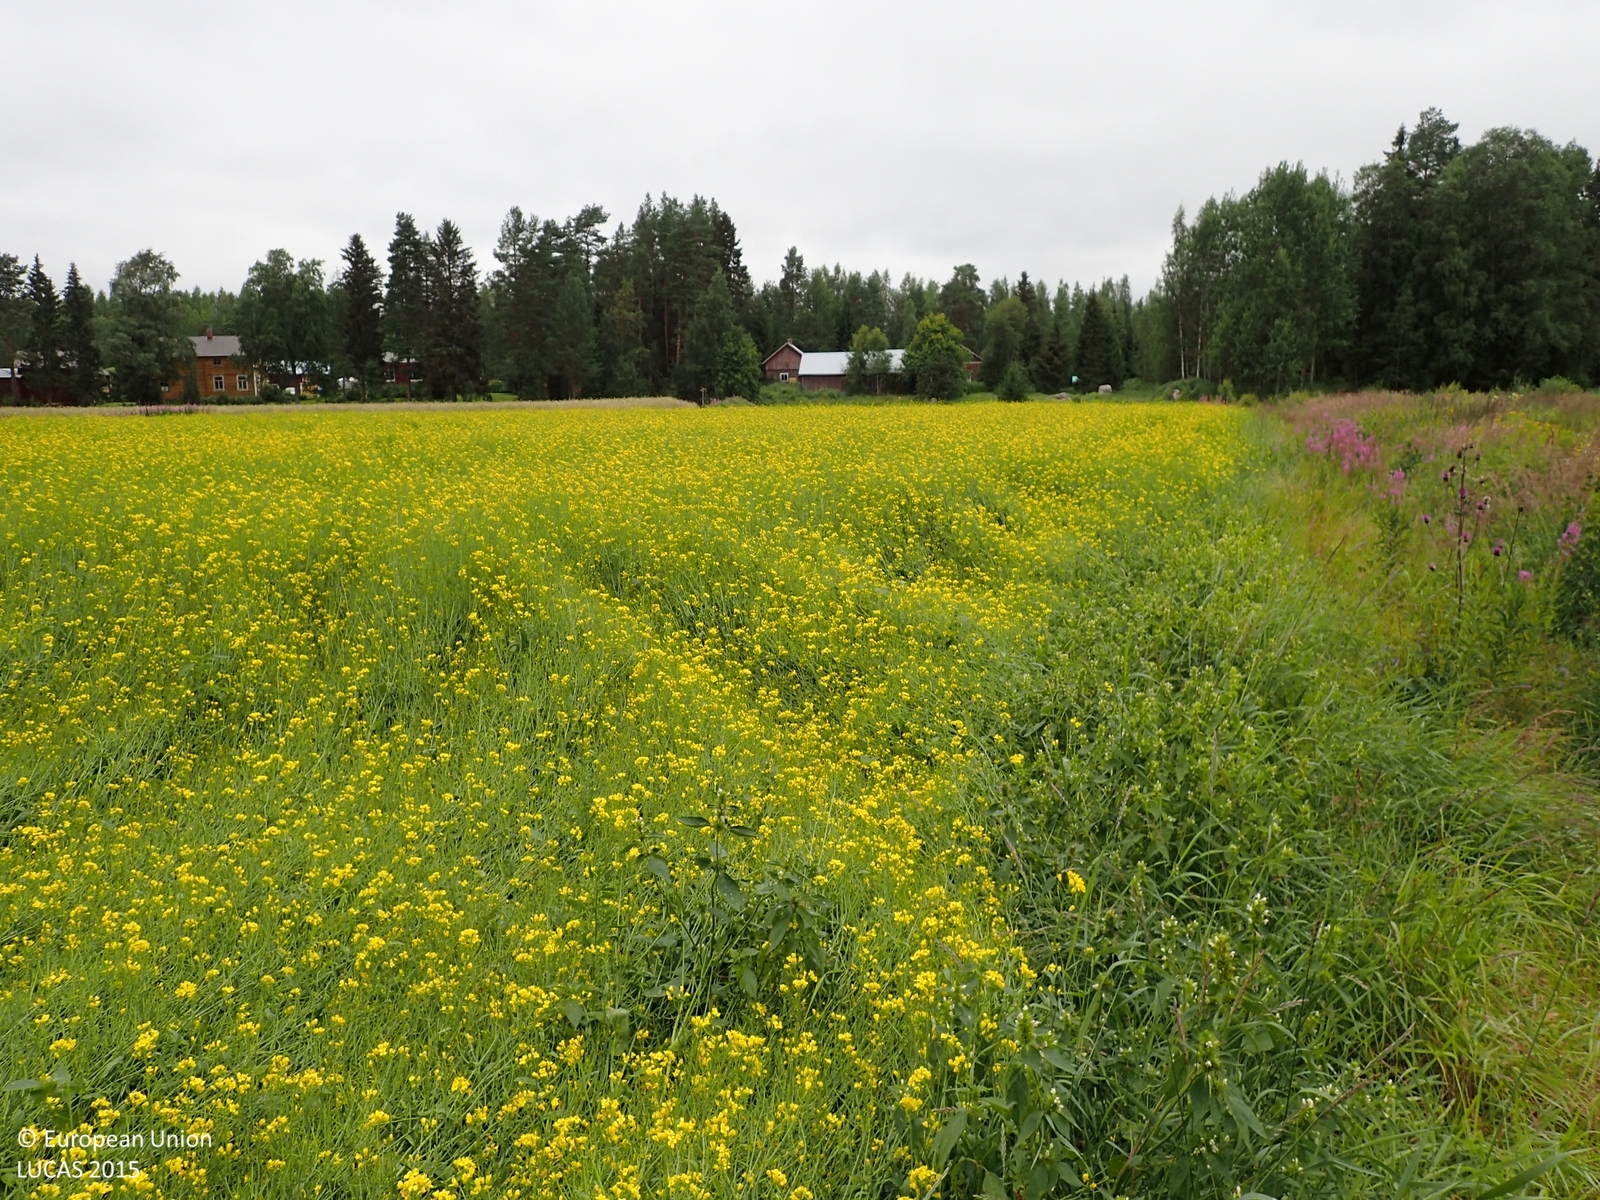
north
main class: Cropland
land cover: Rape and turnip rape
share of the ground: > 75 %
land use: Agriculture (excluding fallow land and kitchen gardens)
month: August
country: FI
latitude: 62.8815
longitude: 21.9820
